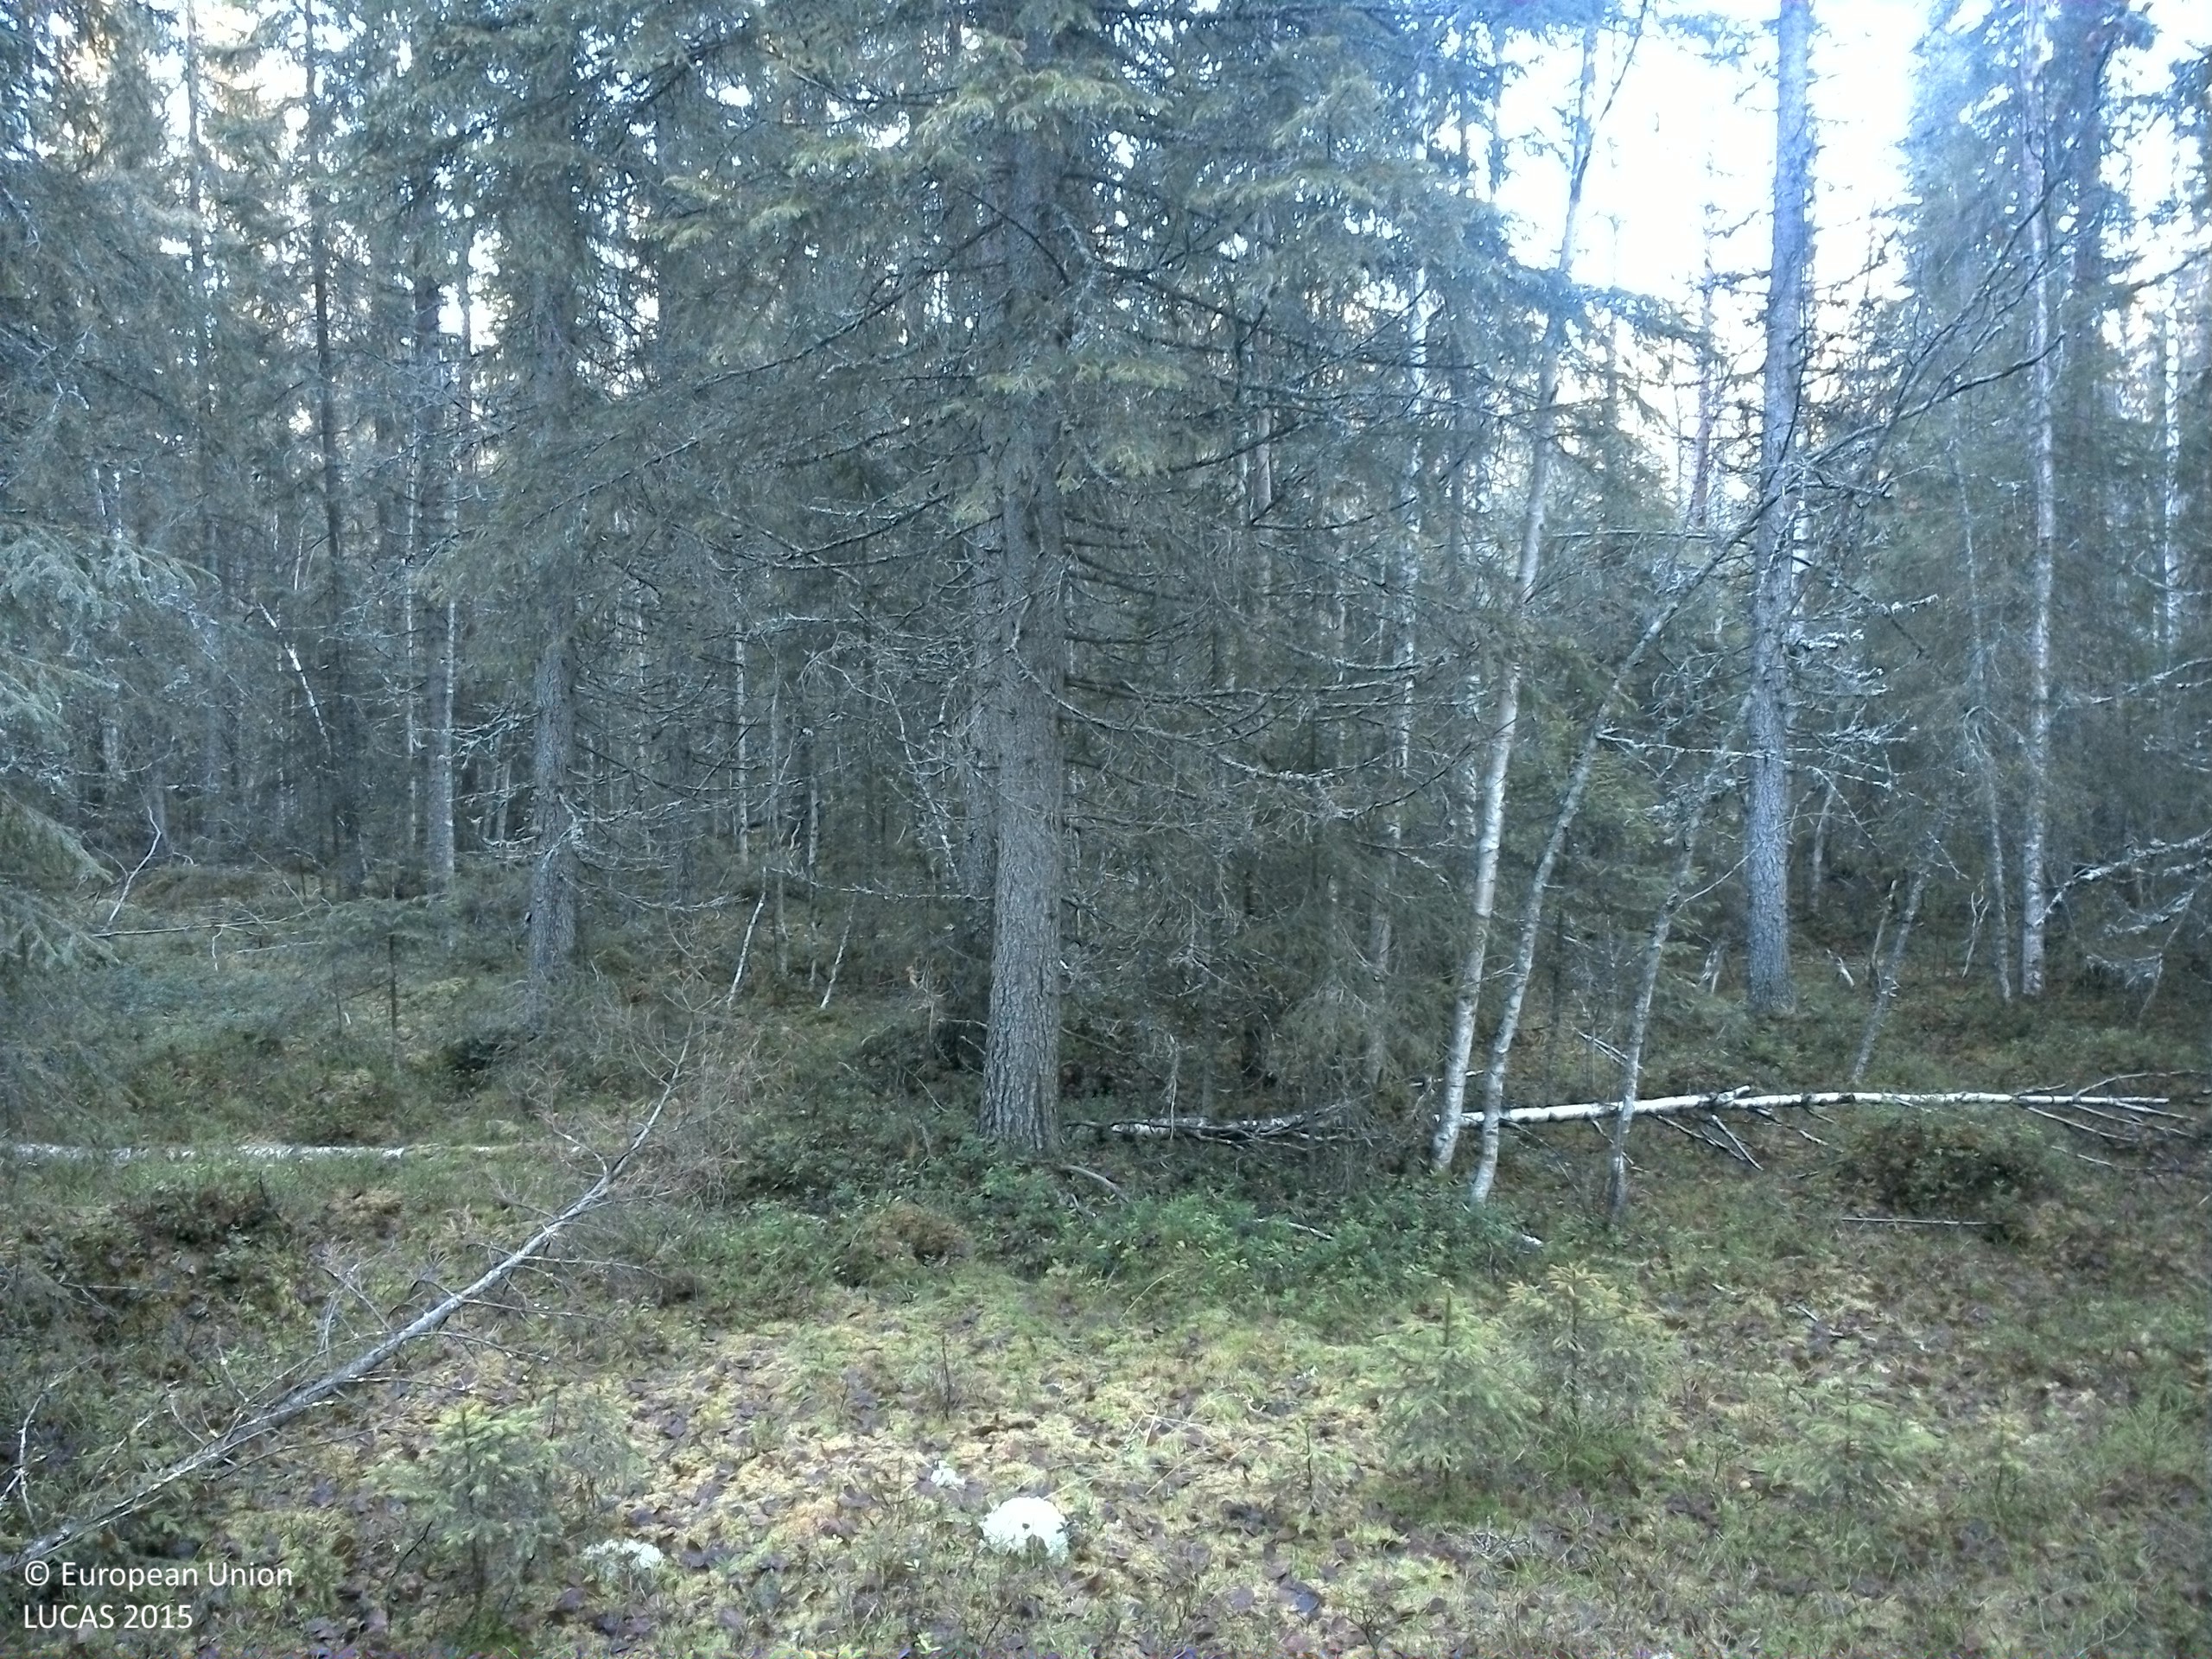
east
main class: Woodland
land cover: Spruce dominated mixed woodland
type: boreal forest
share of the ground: 50 - 75 %
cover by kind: coniferous forest trees 45 %, lichens and mosses 25 %, broadleaved forest trees 15 %, shrubs 15 %
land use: Forestry
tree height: > 5 m
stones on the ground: 25 - 50 %
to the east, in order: Spruce dominated mixed woodland; Other coniferous woodland; Spruce dominated mixed woodland; Spruce dominated coniferous woodland; Spruce dominated mixed woodland; Rivers and streams; Spruce dominated mixed woodland
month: October
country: SE
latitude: 63.8675
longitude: 16.0161
